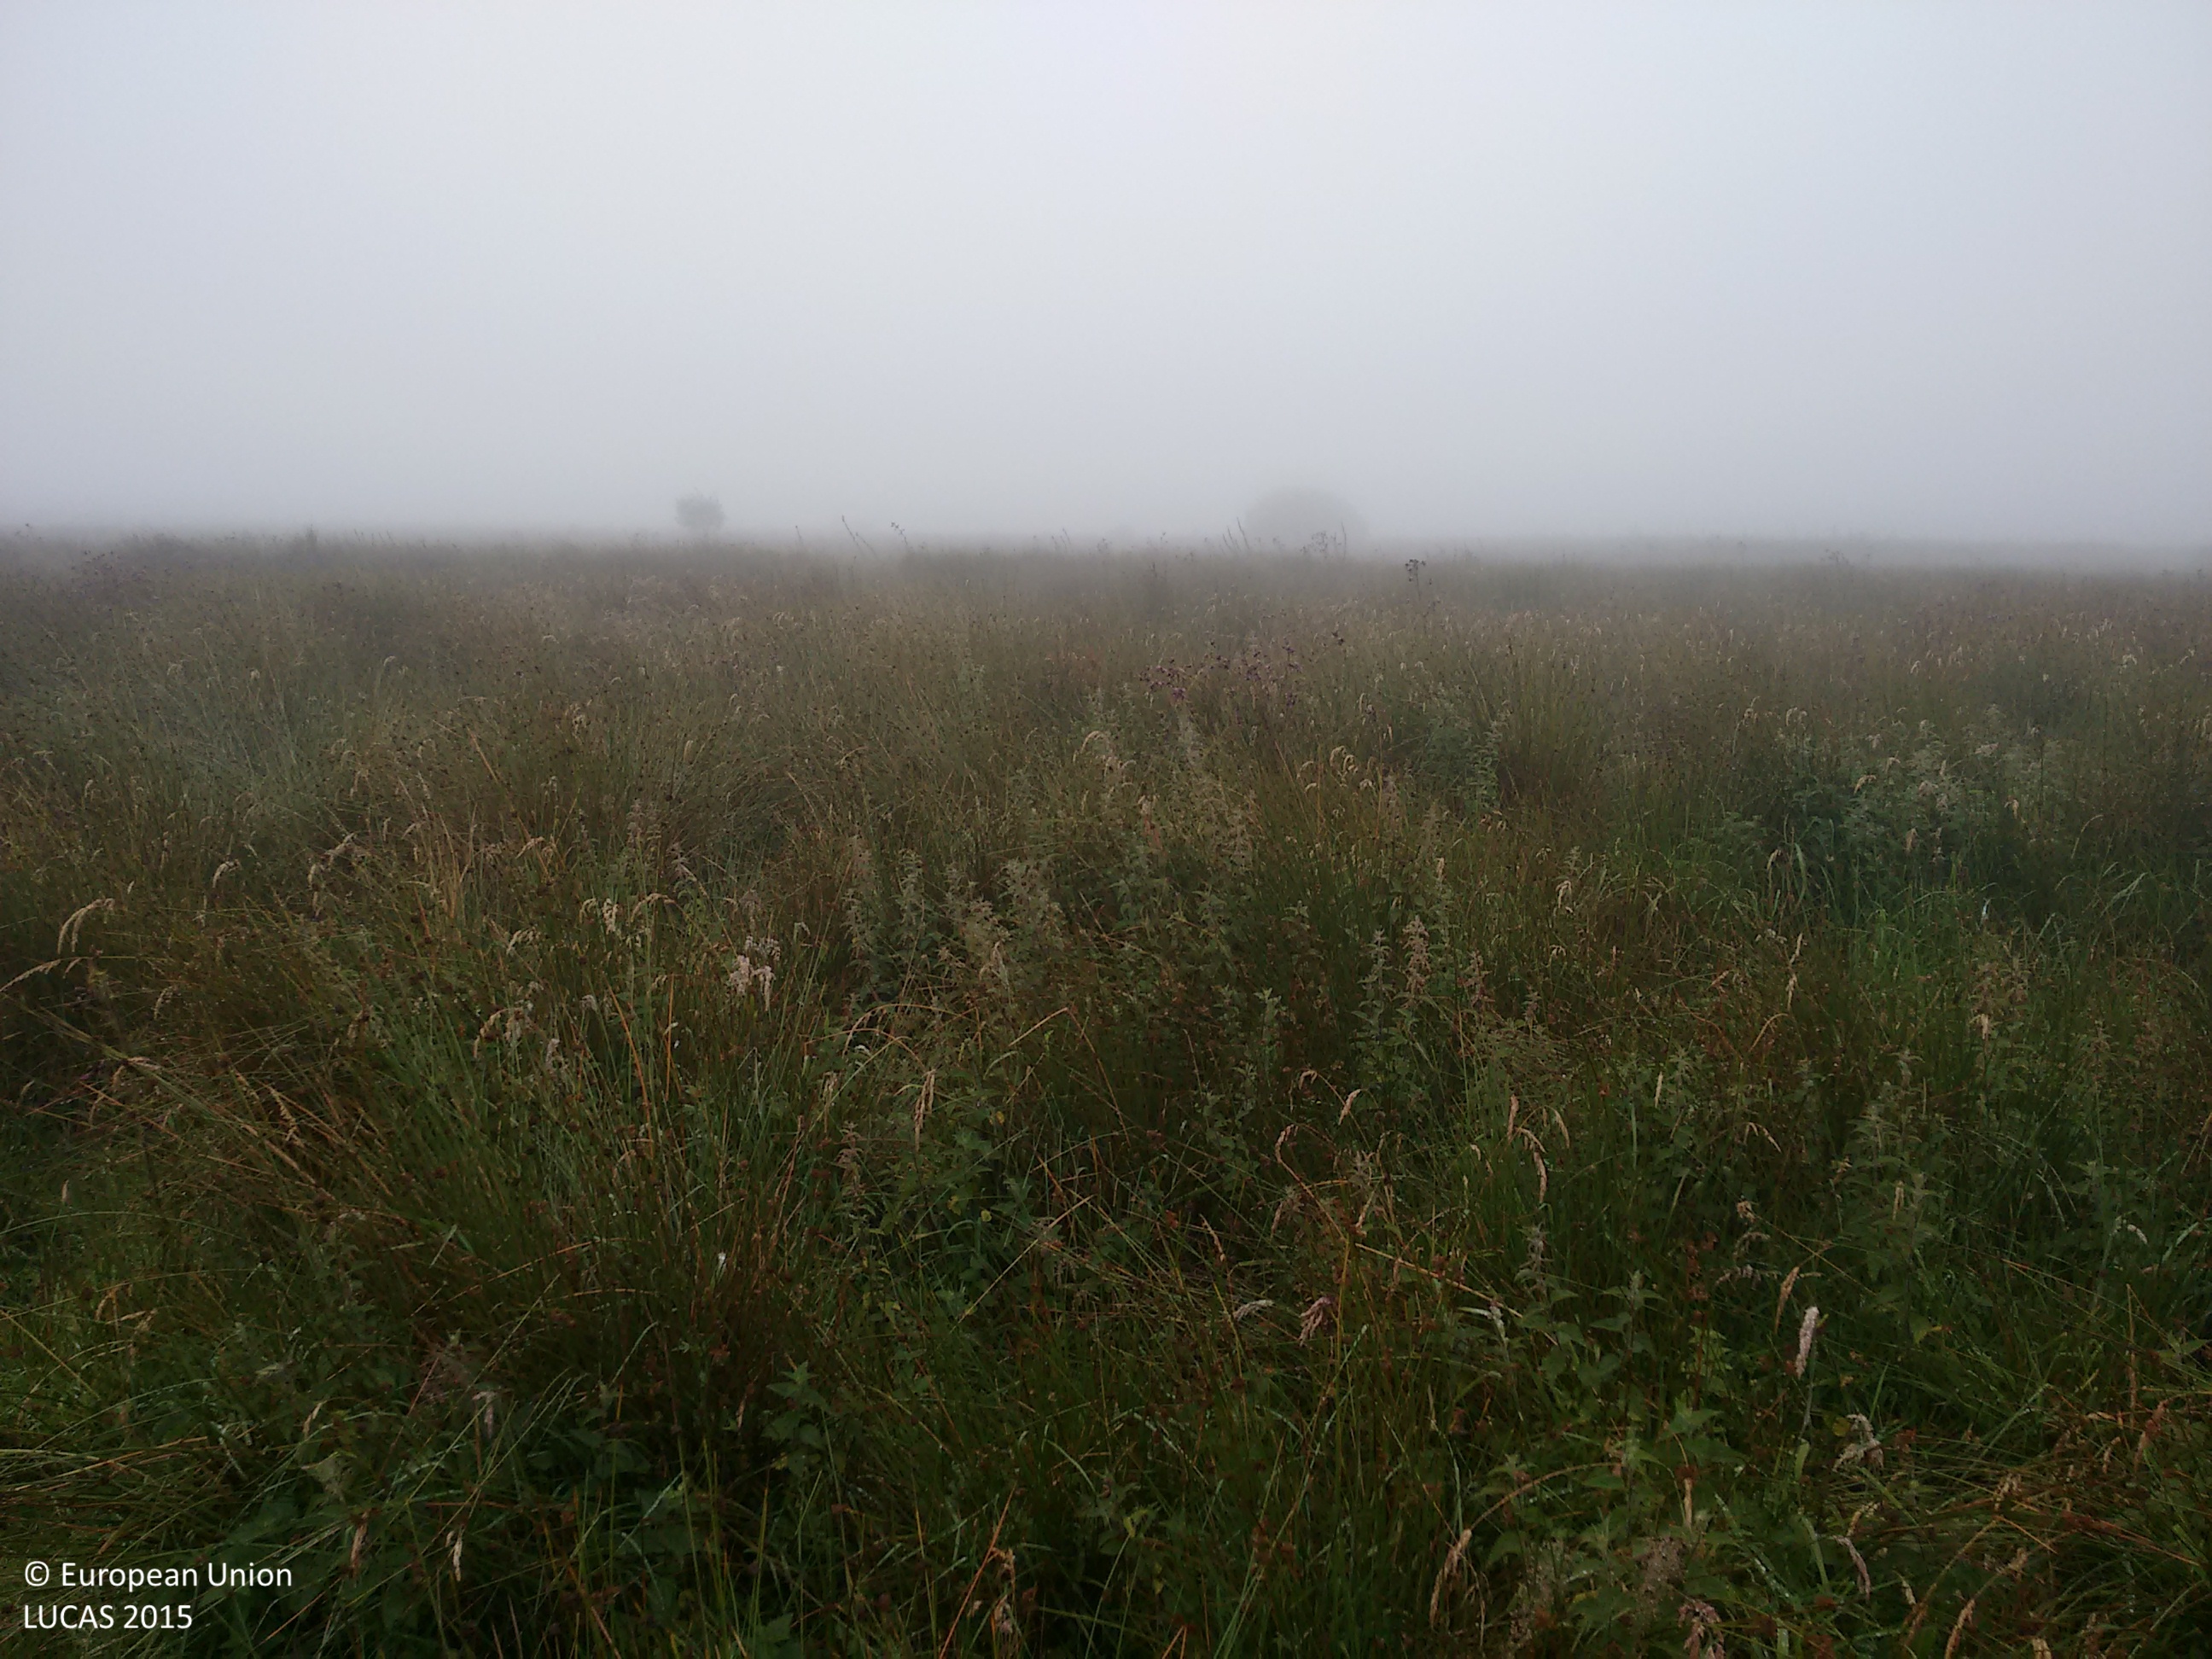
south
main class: Grassland
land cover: Grassland without tree/shrub cover
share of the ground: > 75 %
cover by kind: herbaceous plants 100 %
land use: Agriculture (excluding fallow land and kitchen gardens)
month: August
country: GB
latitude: 50.5567
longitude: -3.9972
